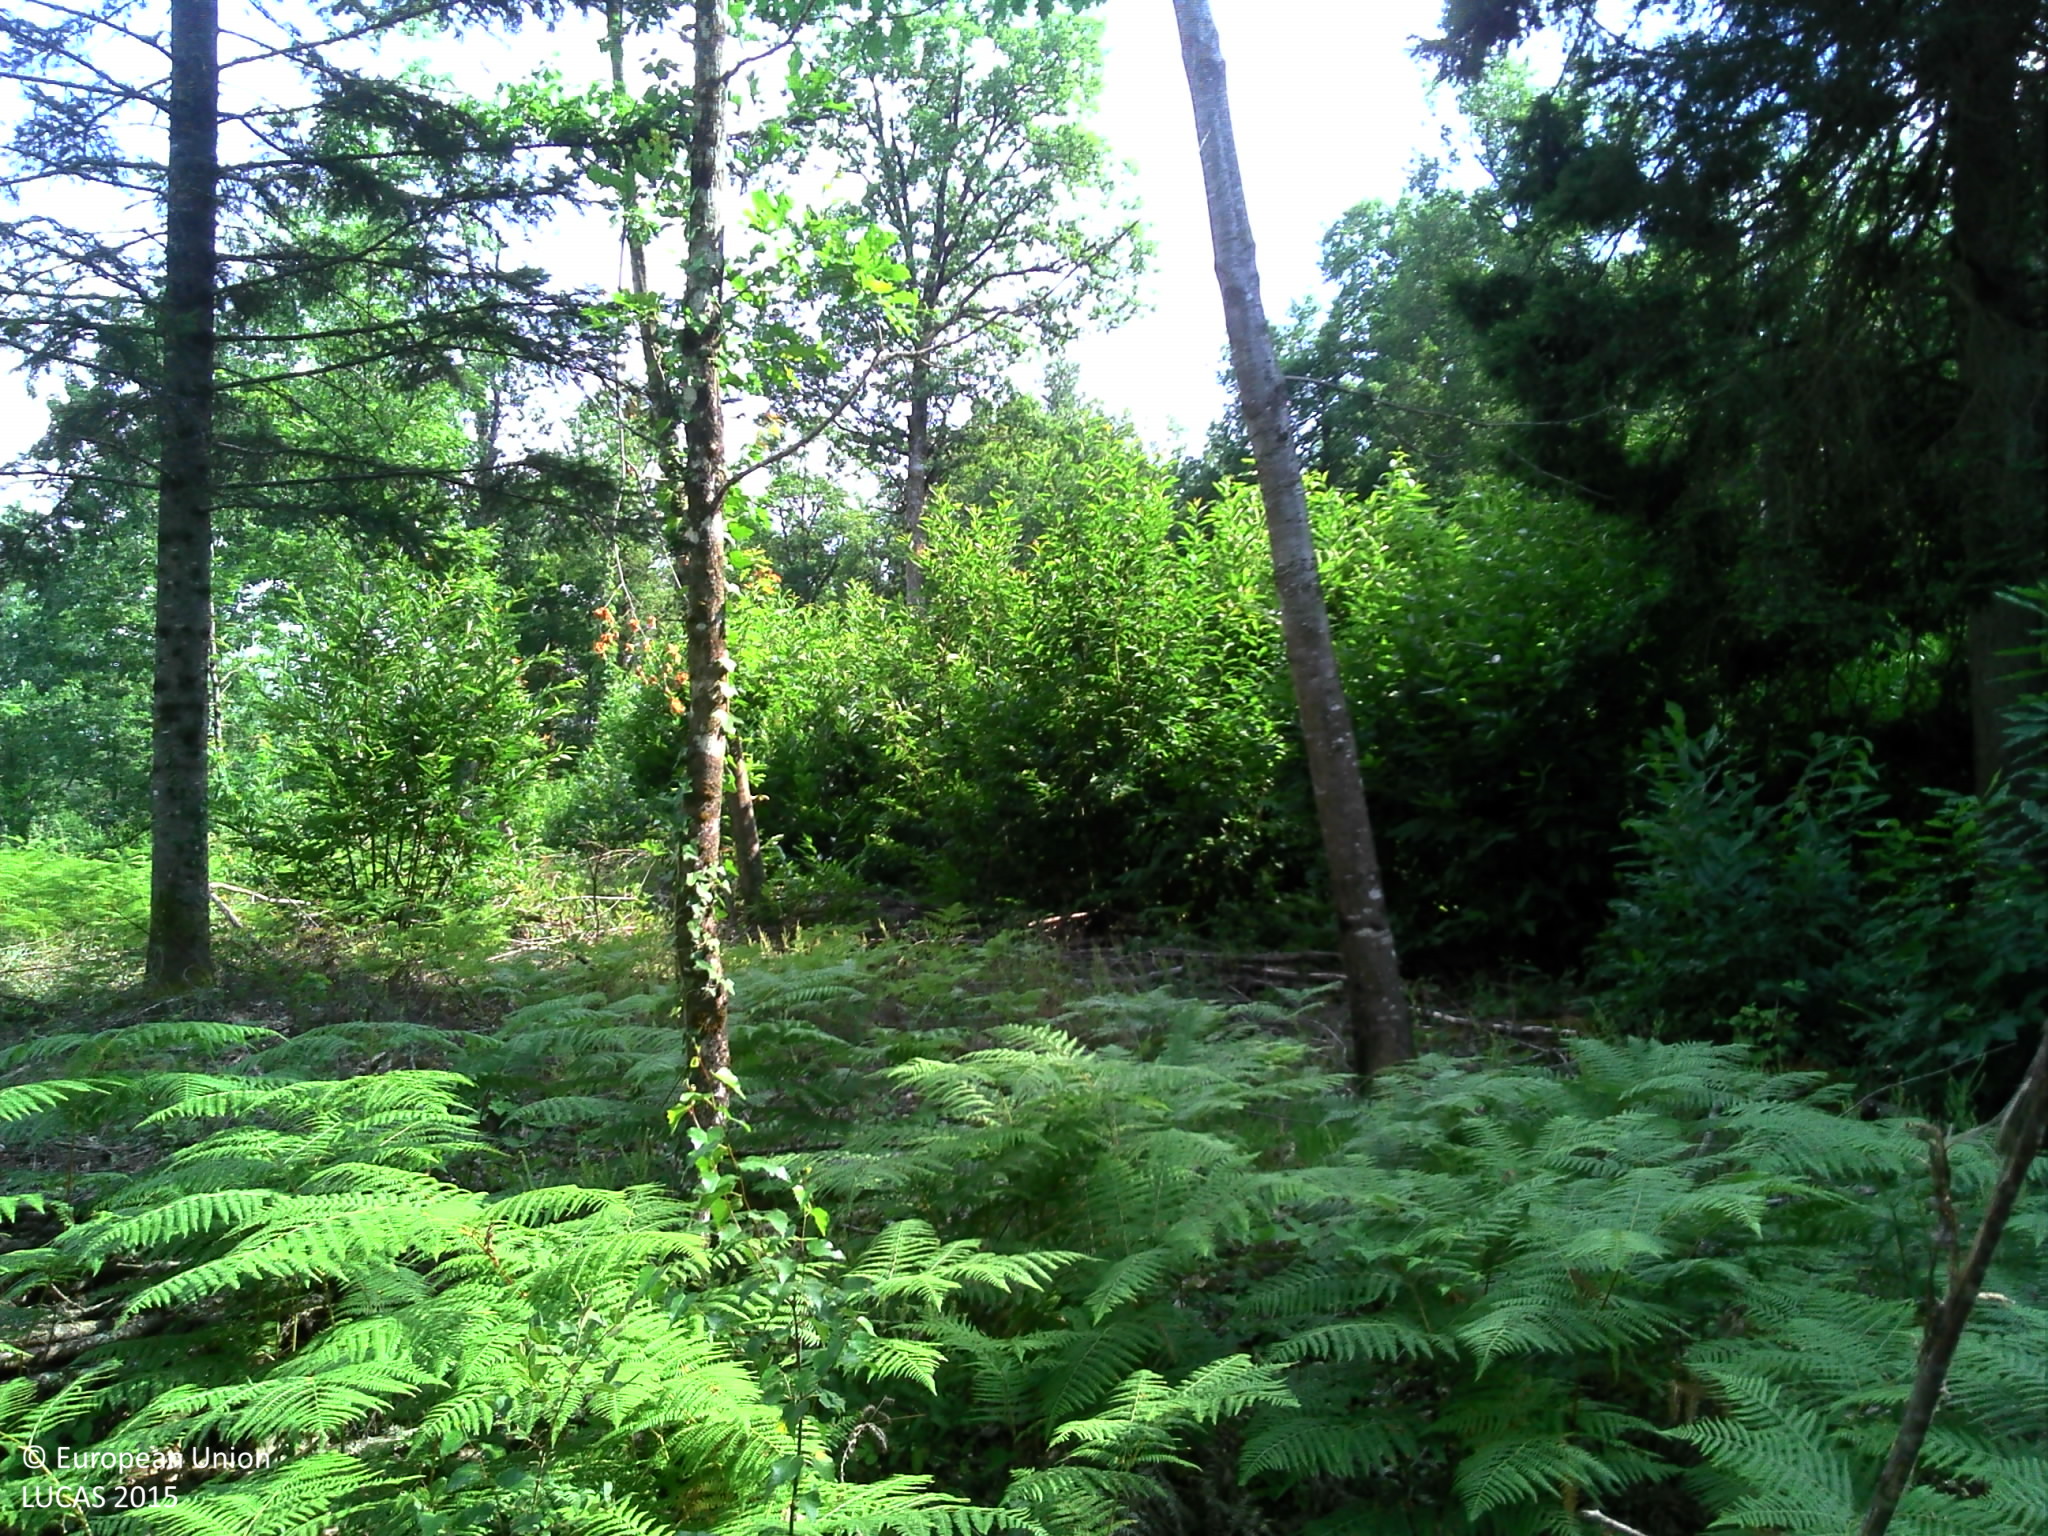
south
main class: Woodland
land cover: Pine dominated mixed woodland
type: acidophilous oak and oak-birch forest
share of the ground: > 75 %
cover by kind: herbaceous plants 40 %, broadleaved forest trees 25 %, lichens and mosses 20 %, coniferous forest trees 10 %
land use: Forestry
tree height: > 5 m
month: July
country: FR
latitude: 45.6804
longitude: 0.9898
